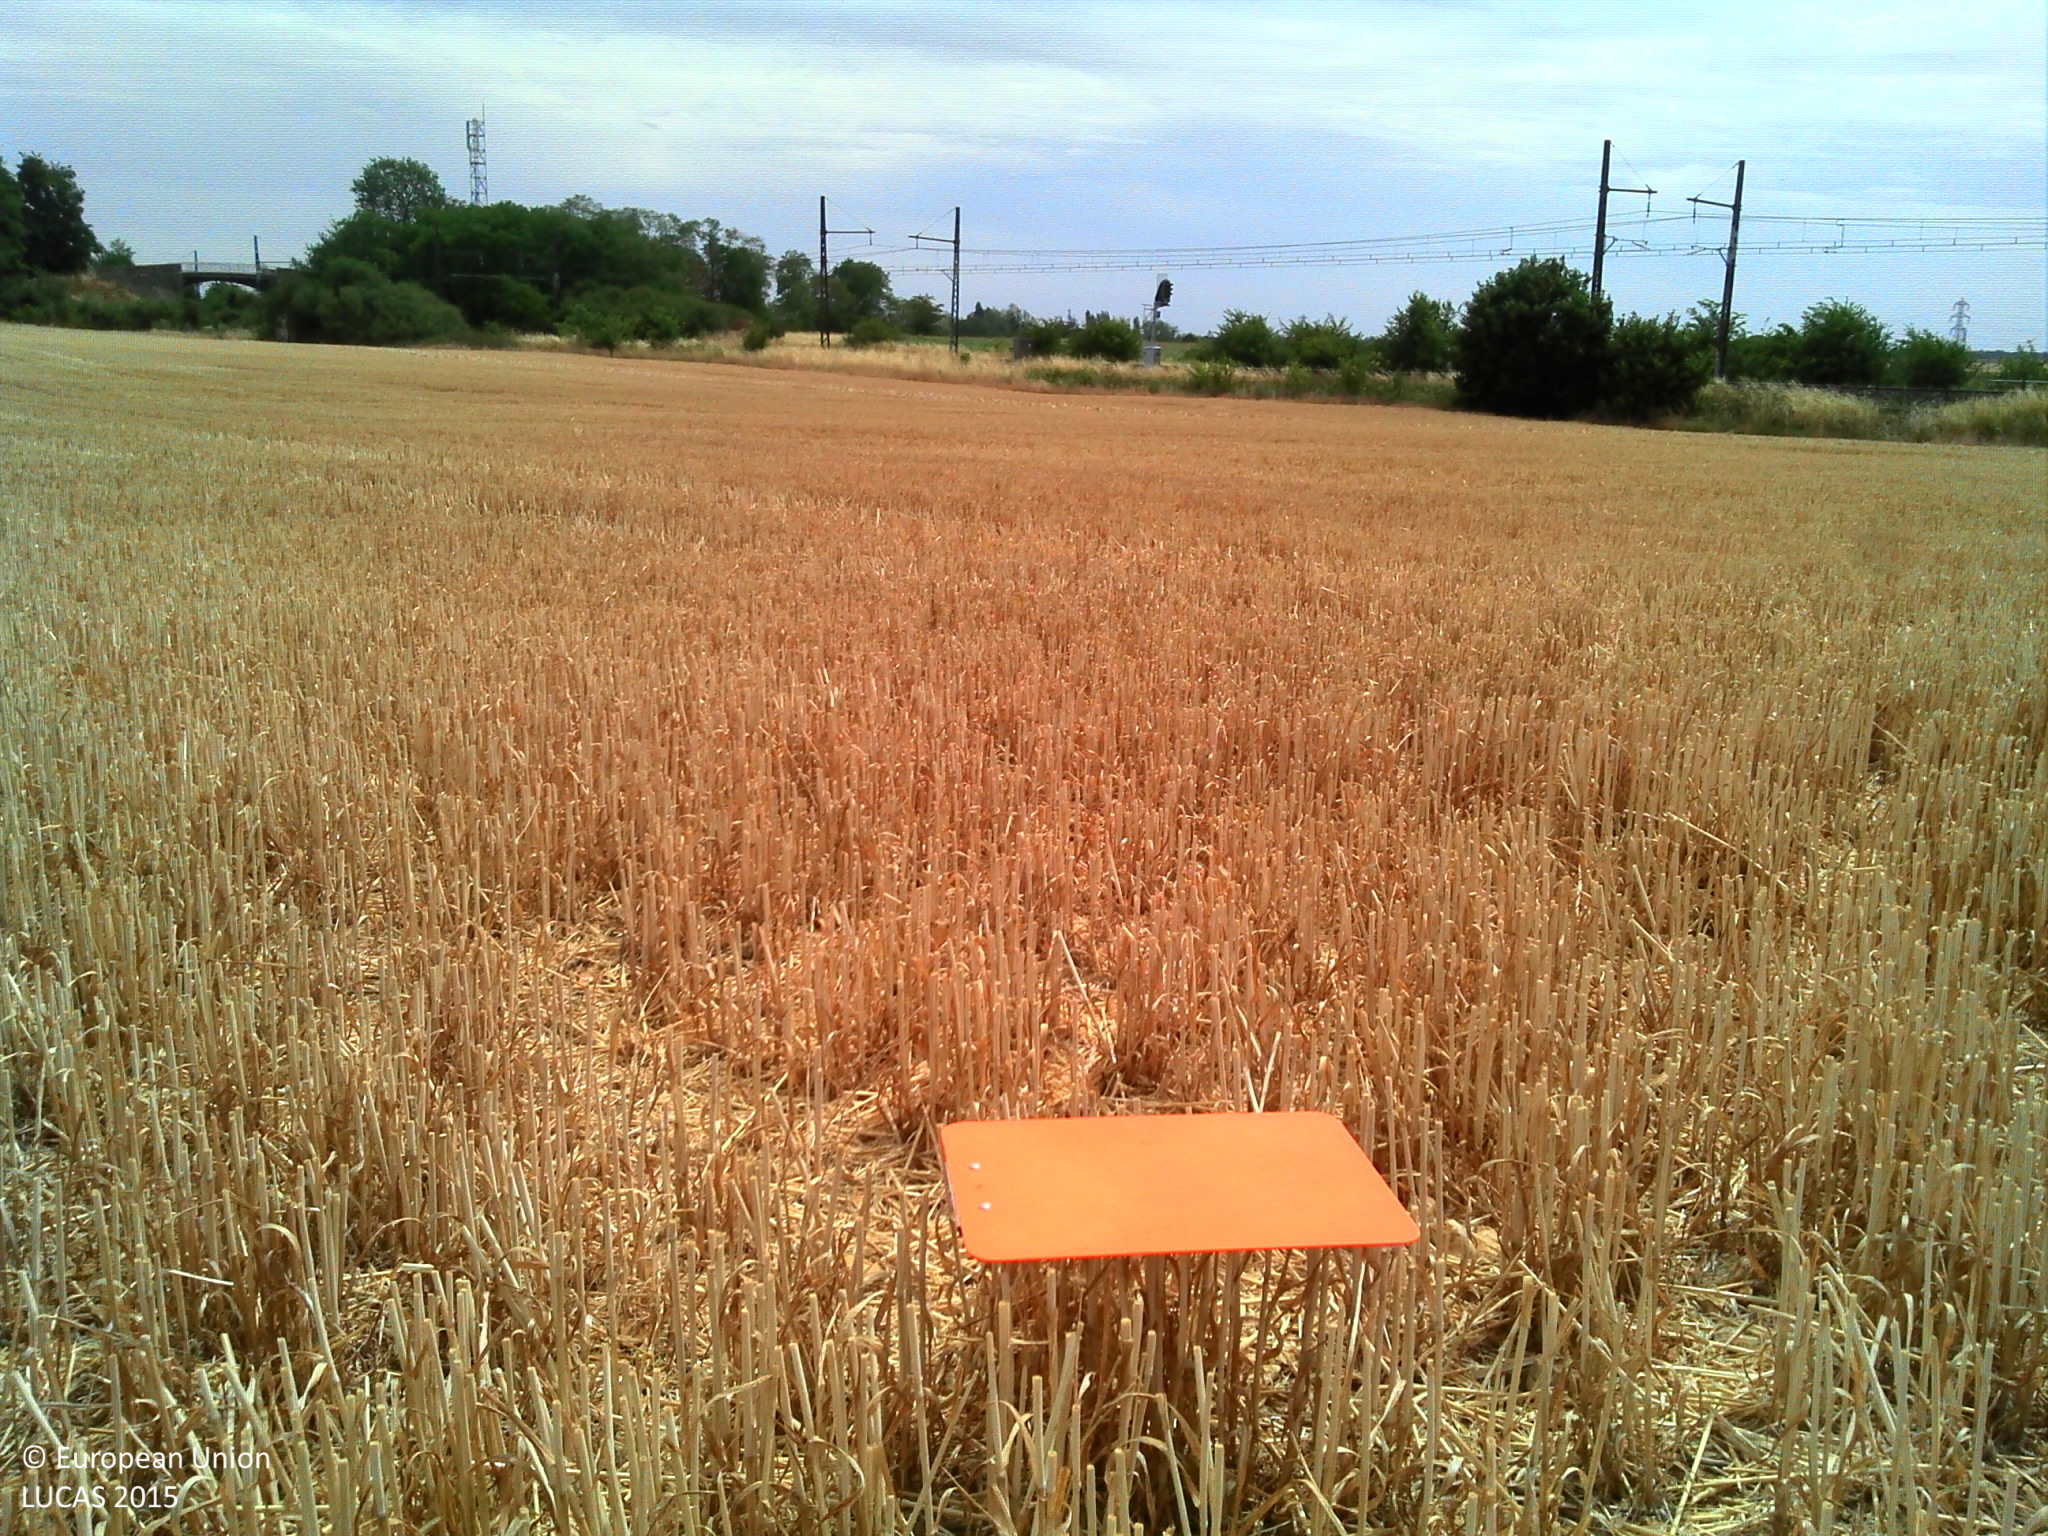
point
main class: Cropland
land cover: Common wheat
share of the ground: > 75 %
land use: Agriculture (excluding fallow land and kitchen gardens)
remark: Harvested field
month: July
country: FR
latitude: 48.4550
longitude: 1.2600
